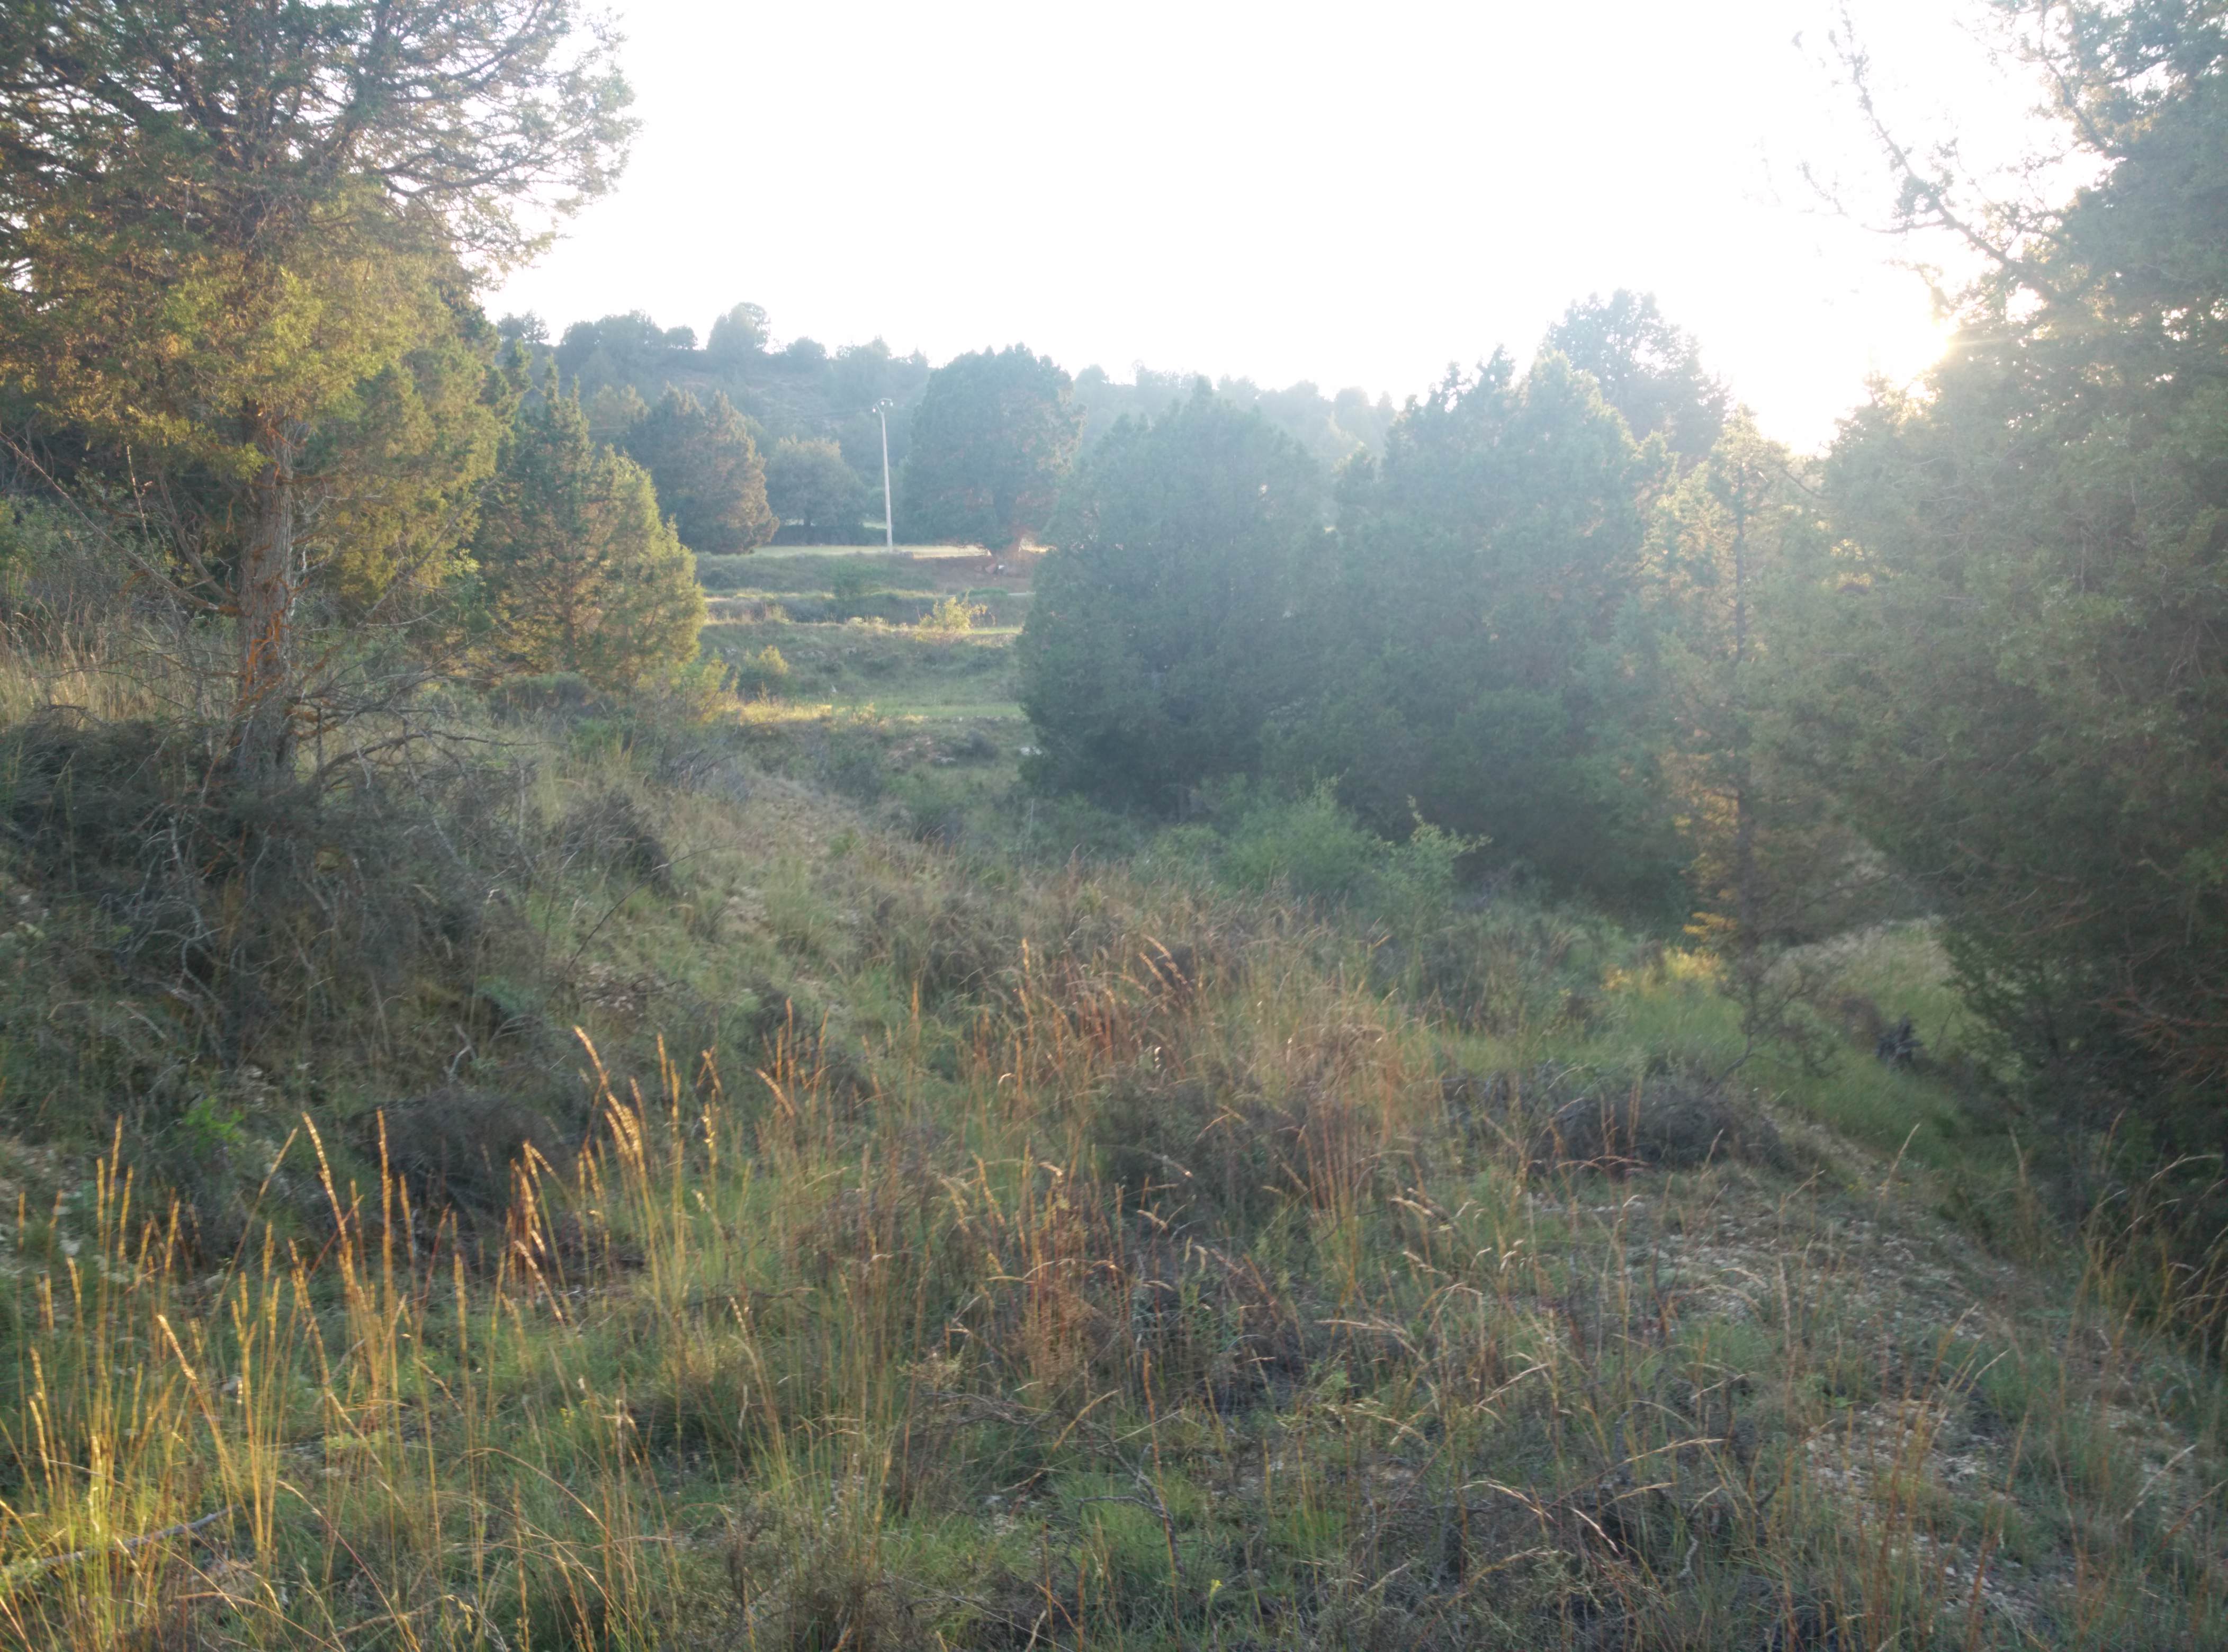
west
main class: Woodland
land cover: Other coniferous woodland
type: coniferous forest of the mediterranean region
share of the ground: 25 - 50 %
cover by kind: unconsolidated bare surface 50 %, coniferous forest trees 25 %, shrubs 15 %, herbaceous plants 10 %
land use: Semi-natural and natural areas not in use
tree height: > 5 m
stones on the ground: > 50 %
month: June
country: ES
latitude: 40.7671
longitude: -2.0235
